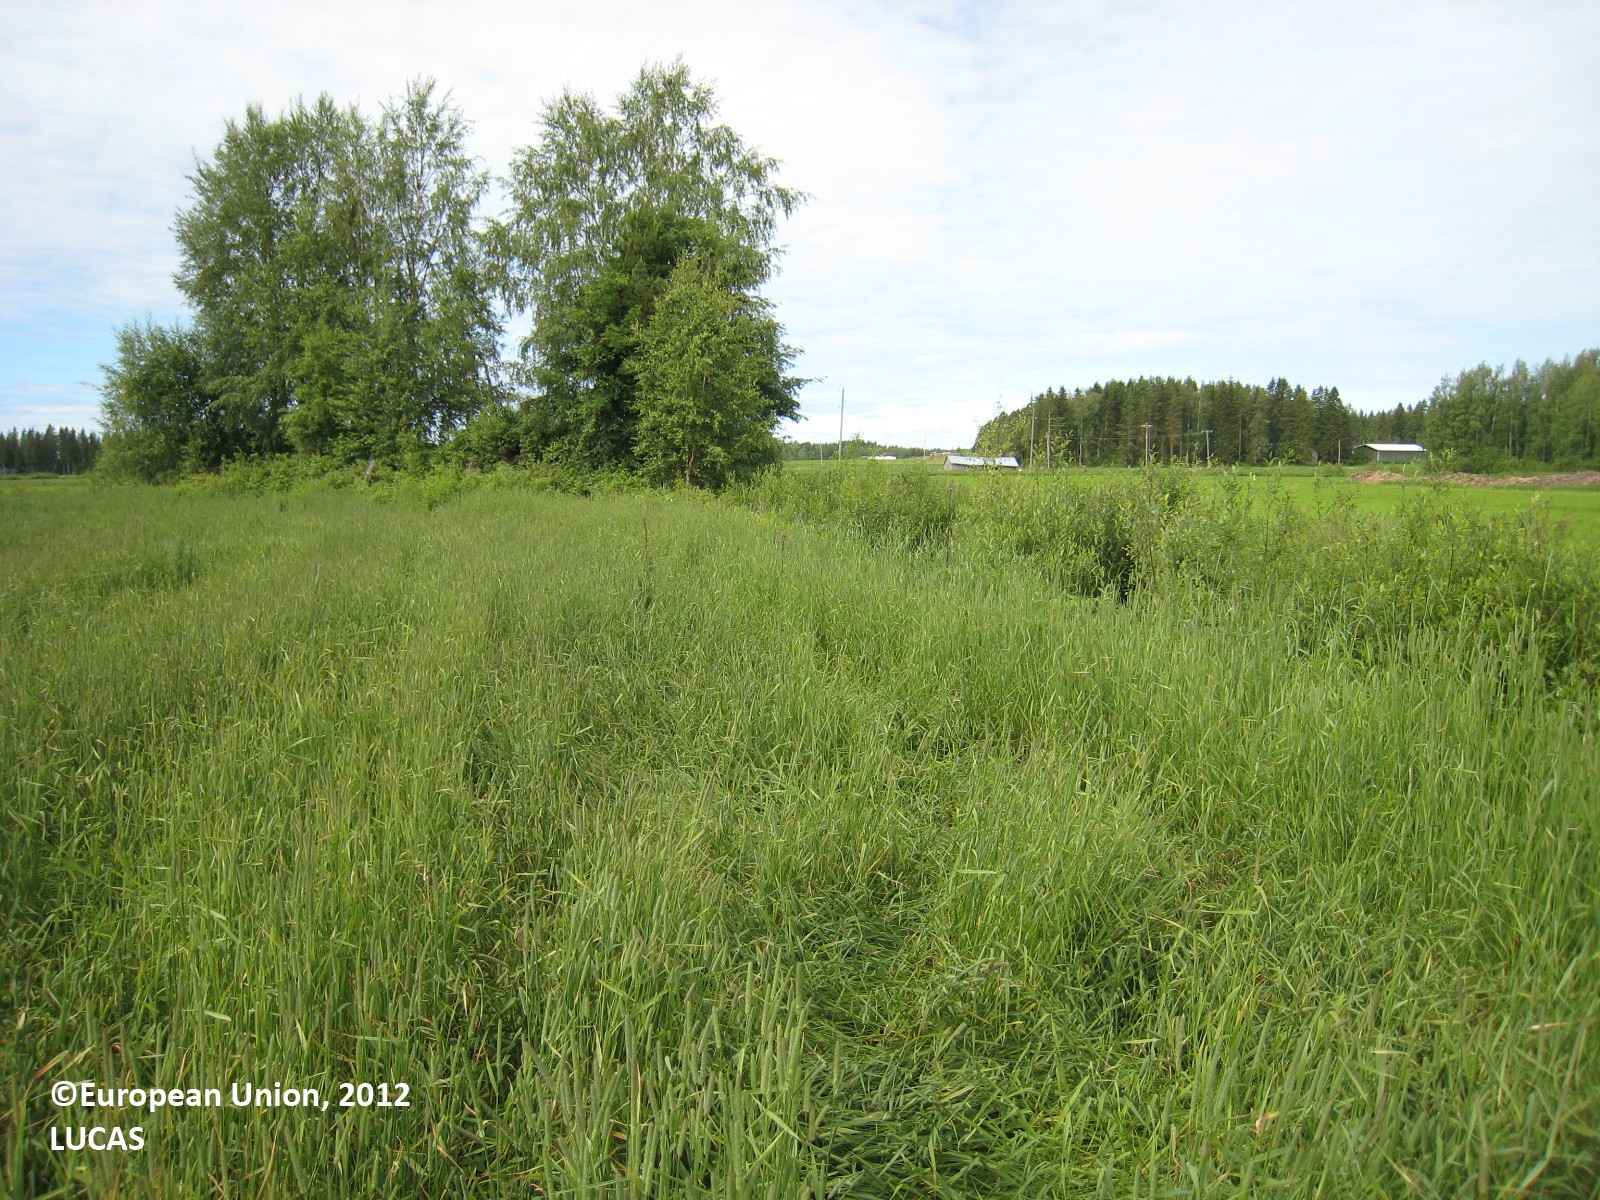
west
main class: Cropland
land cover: Temporary grasslands
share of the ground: > 75 %
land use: Agriculture (excluding fallow land and kitchen gardens)
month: June
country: FI
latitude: 62.3960
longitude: 26.3258
